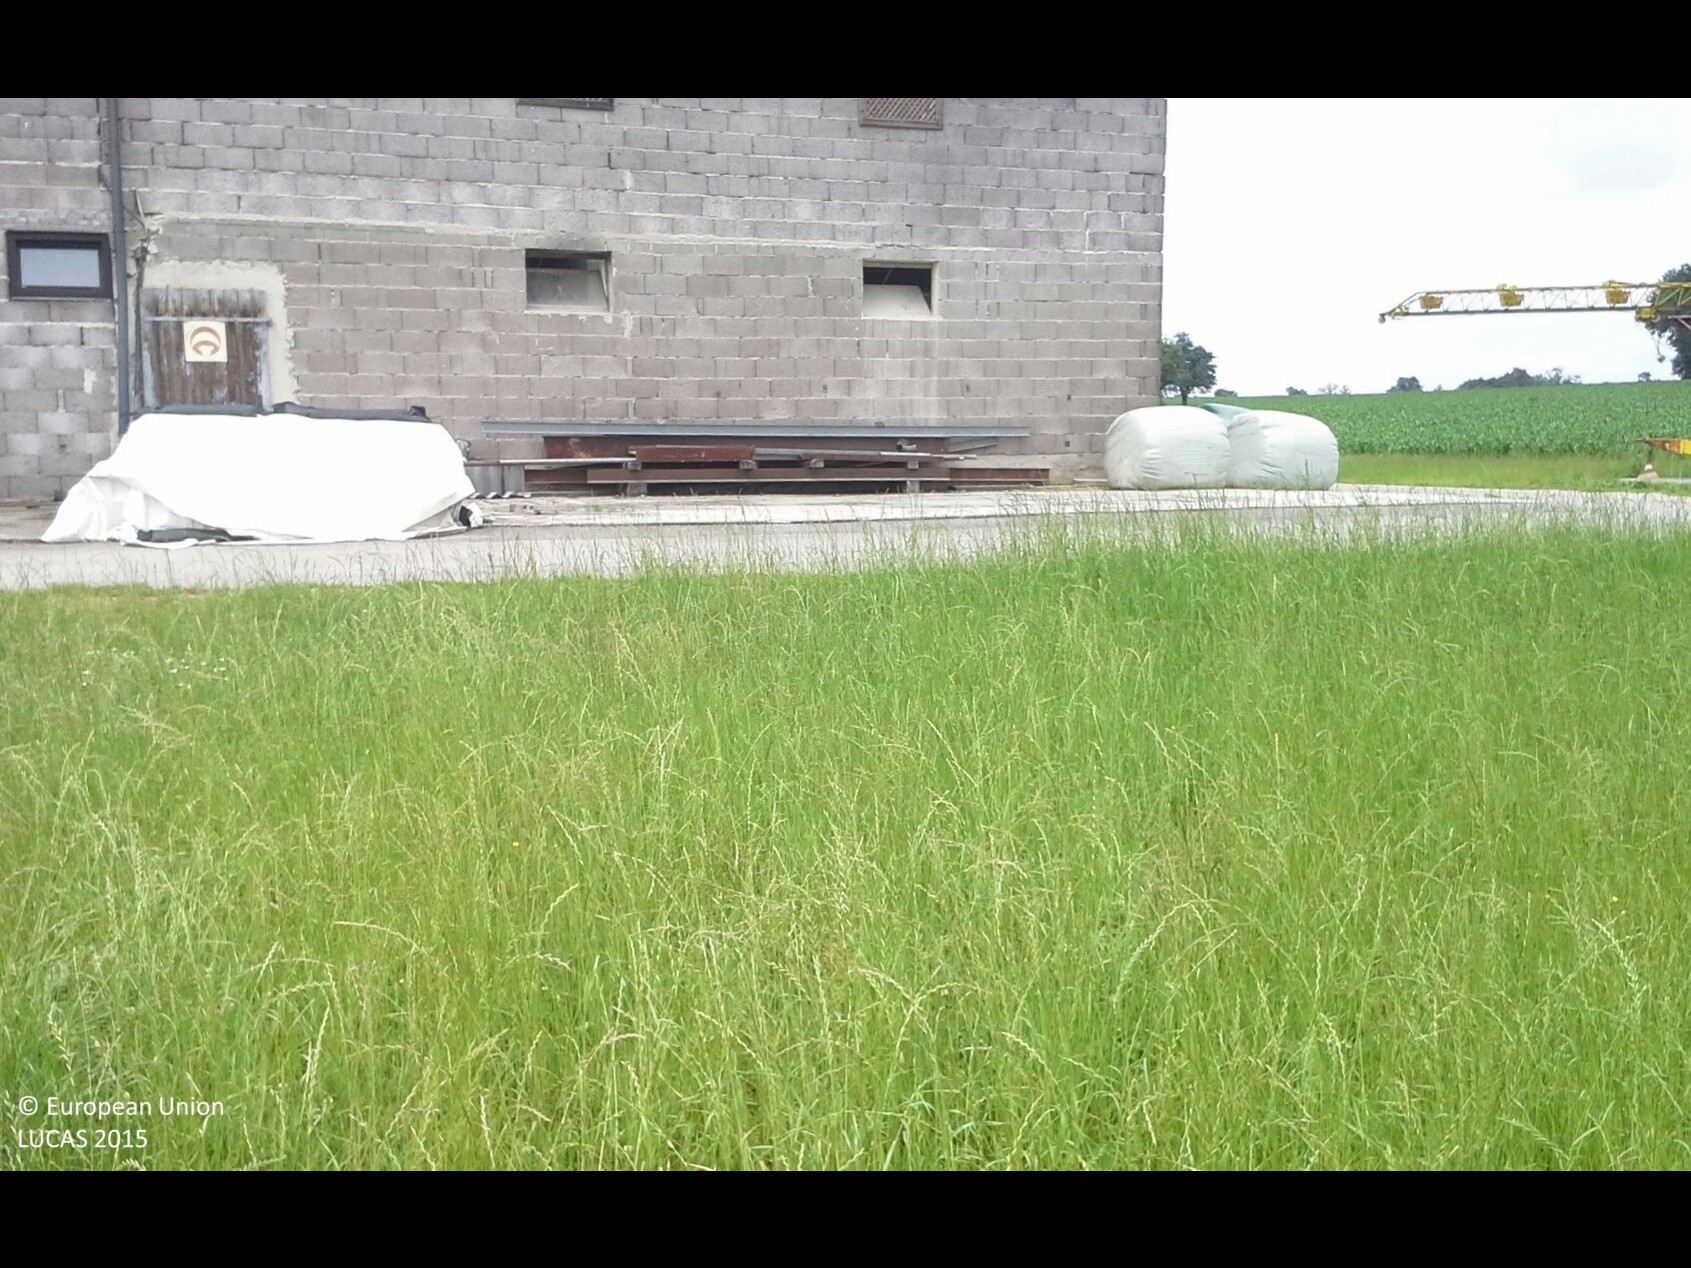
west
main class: Grassland
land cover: Grassland with sparse tree/shrub cover
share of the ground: > 75 %
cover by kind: herbaceous plants 95 %, broadleaved forest trees 5 %
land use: Agriculture (excluding fallow land and kitchen gardens)
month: June
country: AT
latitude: 48.0565
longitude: 14.5755
